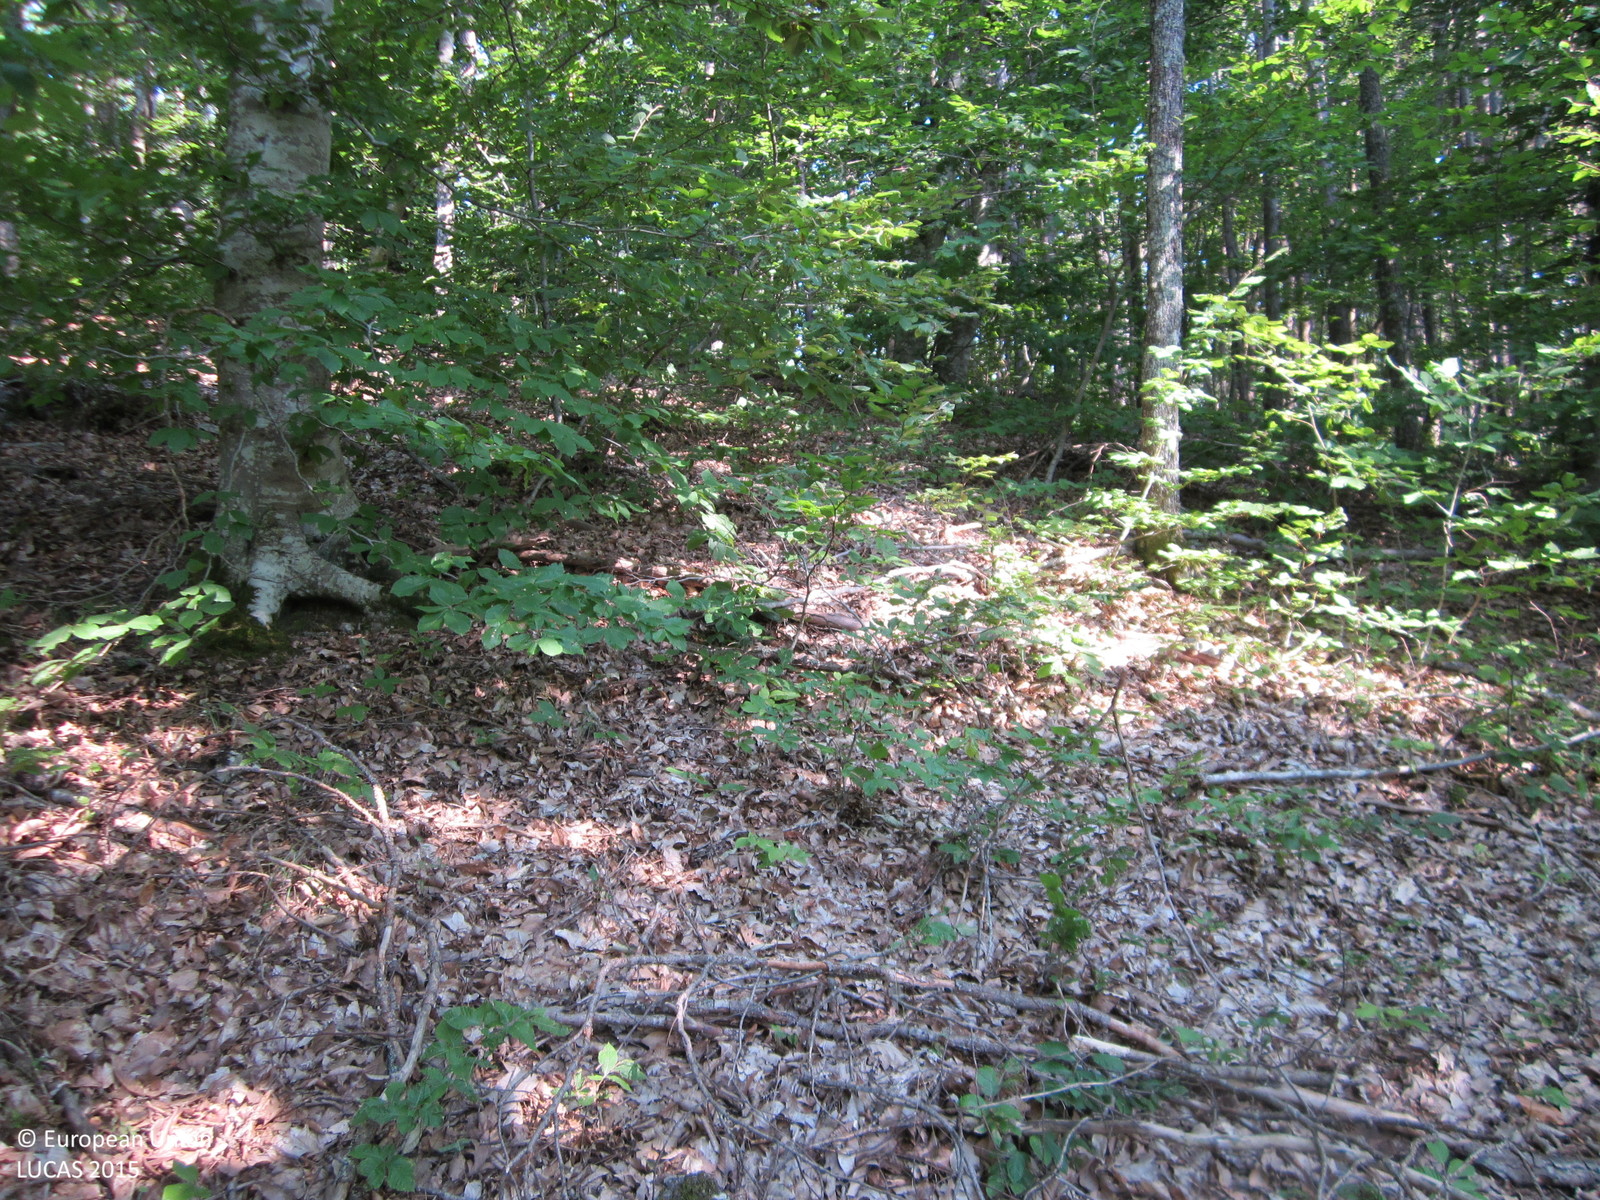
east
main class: Woodland
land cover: Broadleaved woodland
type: beech forest
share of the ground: > 75 %
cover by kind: broadleaved forest trees 80 %, unconsolidated bare surface 10 %, herbaceous plants 5 %, lichens and mosses 5 %
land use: Forestry
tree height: > 5 m
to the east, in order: Broadleaved woodland; Pine dominated mixed woodland; Broadleaved woodland; Pine dominated mixed woodland; Tracks; Pine dominated mixed woodland
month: August
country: BG
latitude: 42.0392
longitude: 27.4946
